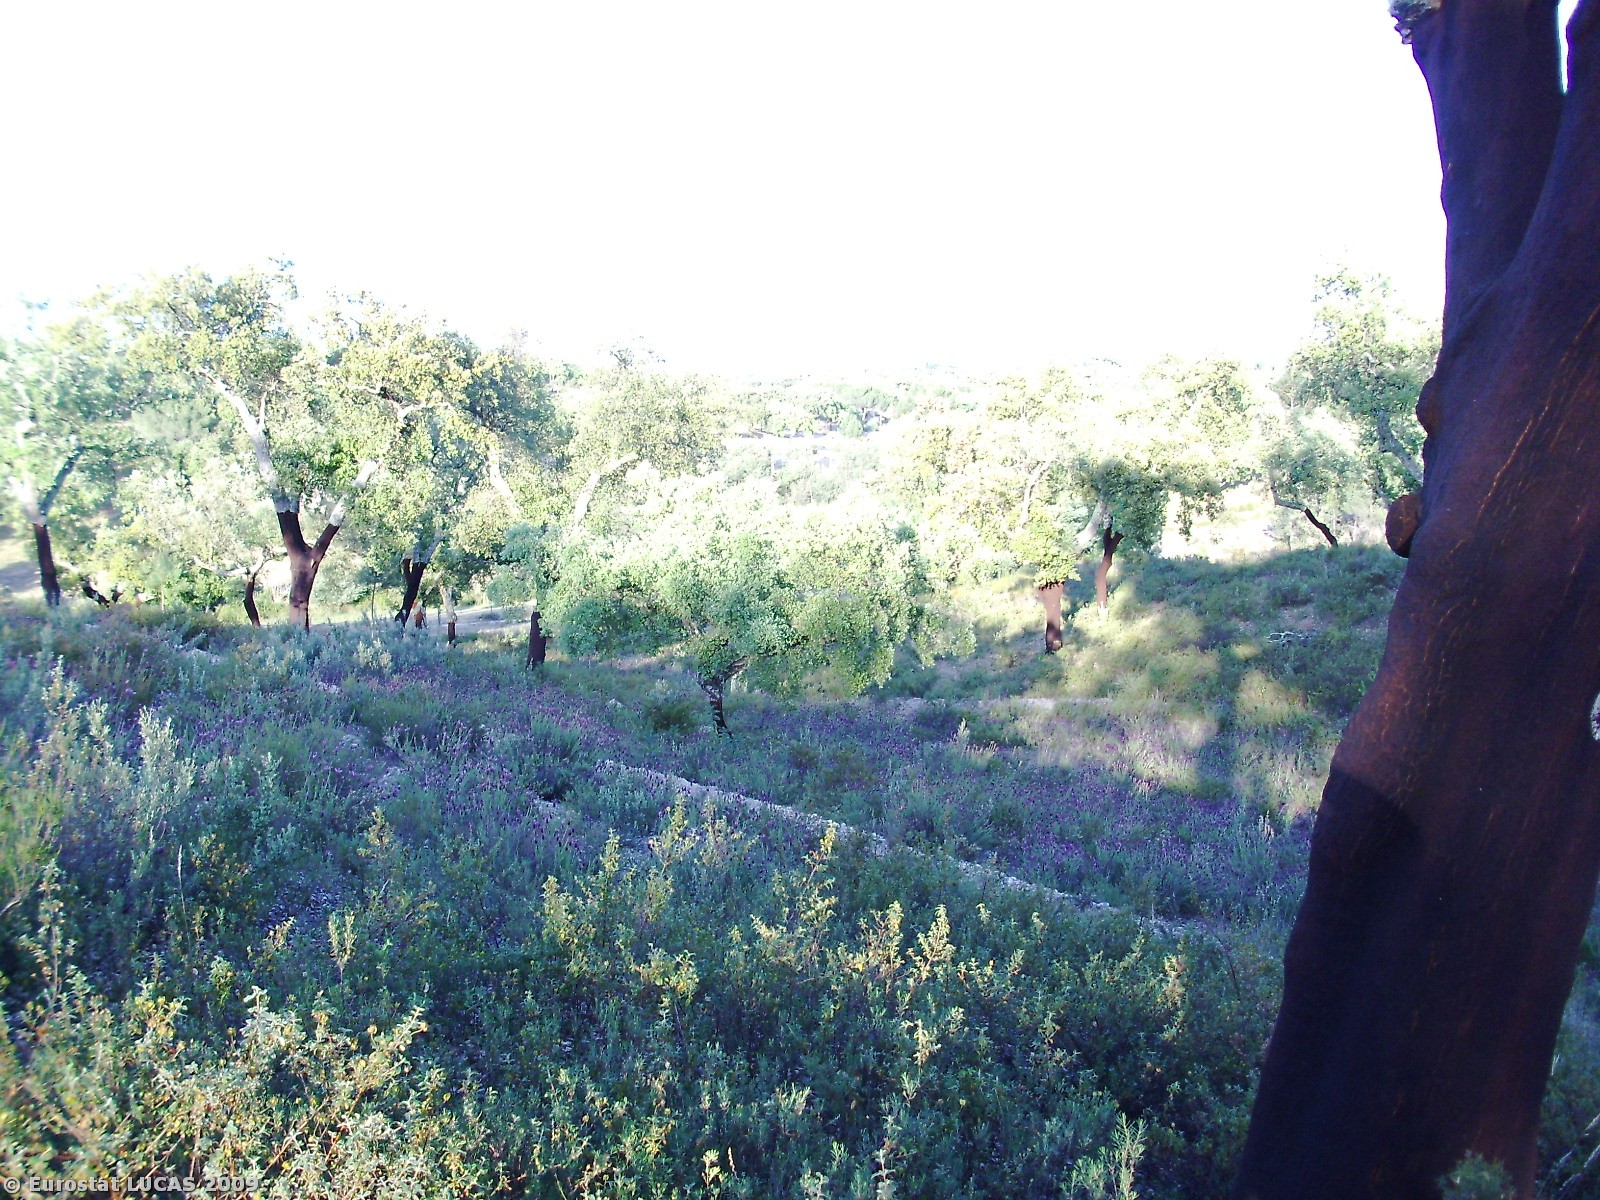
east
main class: Woodland
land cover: Broadleaved woodland
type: broadleaved evergreen forest
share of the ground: 25 - 50 %
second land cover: Spontaneously vegetated surfaces
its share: 50 - 75 %
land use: Forestry
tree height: > 5 m
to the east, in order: Broadleaved woodland; Spontaneously vegetated surfaces; Broadleaved woodland; Tracks; Fences; Grassland without tree/shrub cover; Broadleaved woodland; Ditches and canals; Spontaneously vegetated surfaces; Tracks; Olive groves
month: May
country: PT
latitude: 39.1989
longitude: -7.9895
